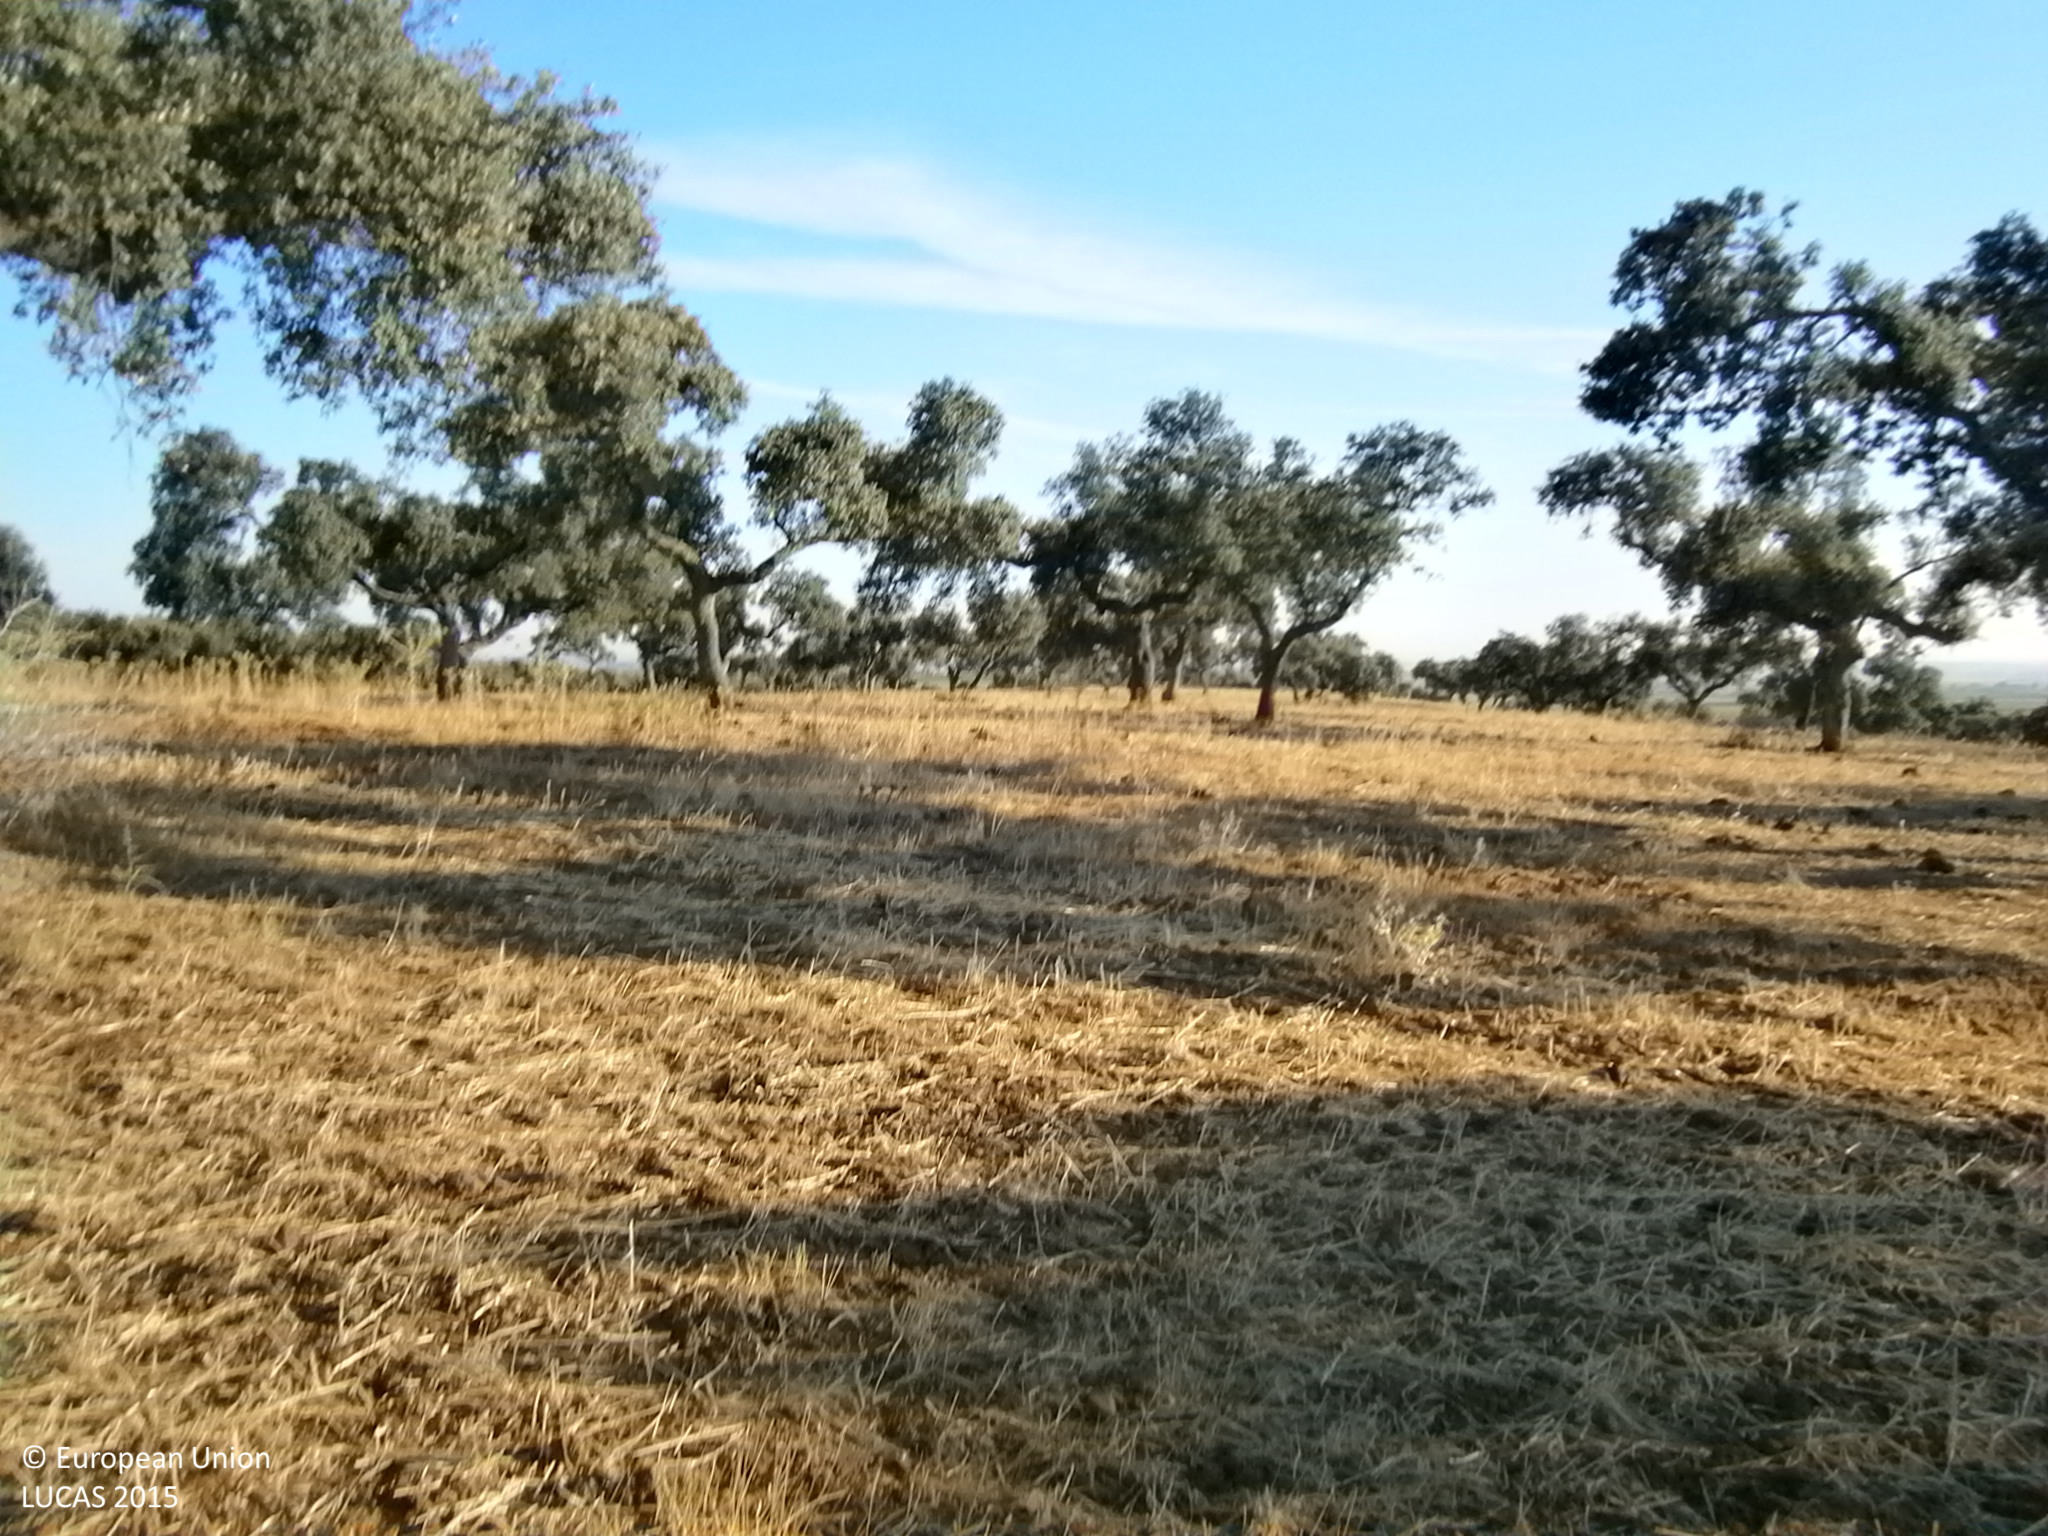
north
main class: Woodland
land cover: Broadleaved woodland
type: broadleaved evergreen forest
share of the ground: 50 - 75 %
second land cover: Spontaneously vegetated surfaces
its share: 50 - 75 %
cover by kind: broadleaved forest trees 45 %, herbaceous plants 45 %, shrubs 5 %, unconsolidated bare surface 5 %
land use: Forestry
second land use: Agriculture (excluding fallow land and kitchen gardens)
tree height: > 5 m
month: June
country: ES
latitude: 38.8449
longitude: -6.4773
